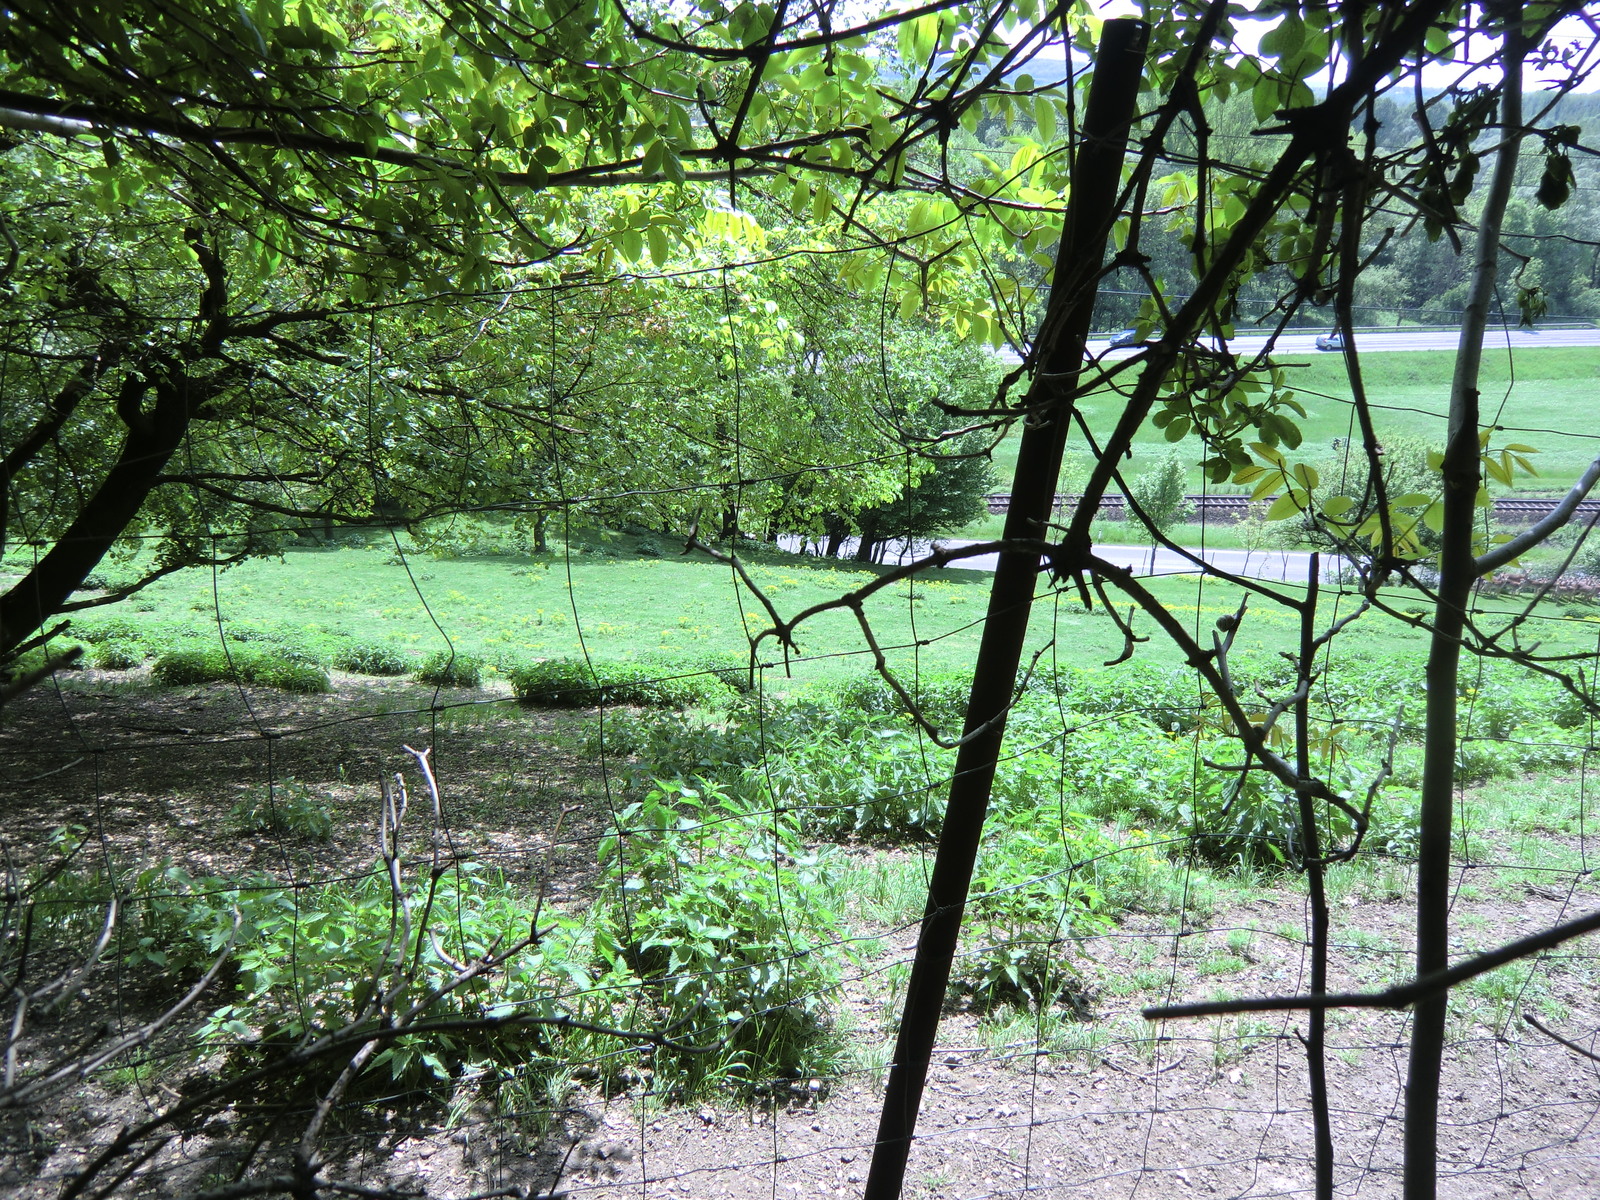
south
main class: Grassland
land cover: Grassland without tree/shrub cover
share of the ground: > 75 %
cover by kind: herbaceous plants 100 %
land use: Agriculture (excluding fallow land and kitchen gardens)
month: May
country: AT
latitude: 48.2807
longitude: 14.3798
